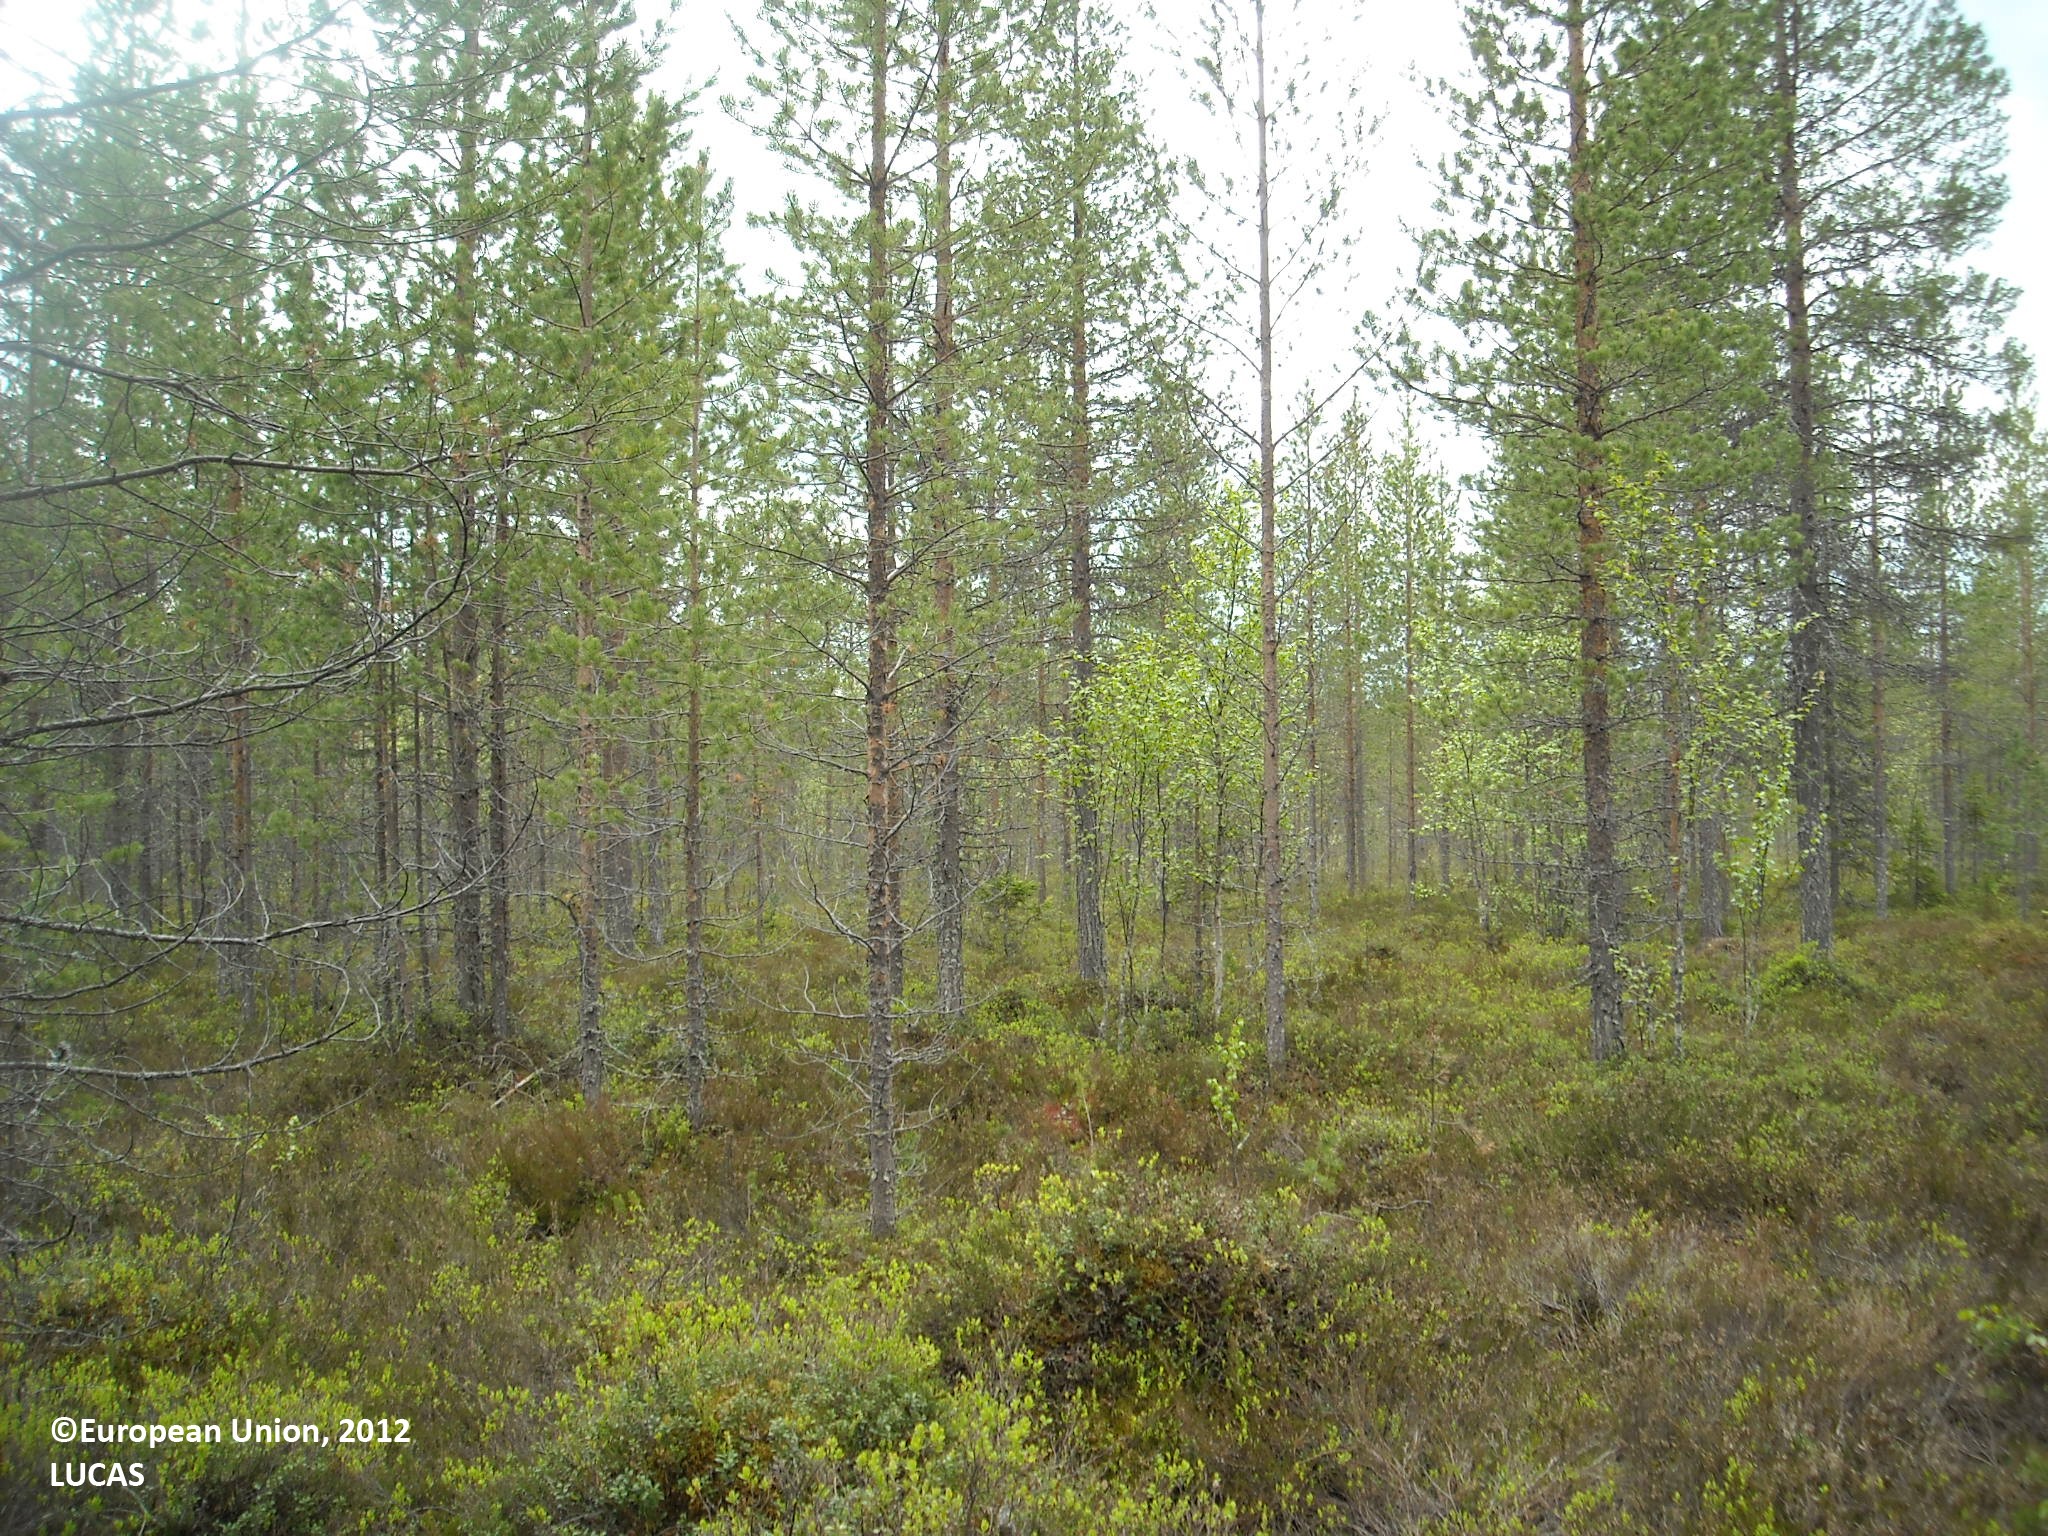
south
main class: Woodland
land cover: Pine dominated mixed woodland
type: boreal forest
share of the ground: > 75 %
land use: Forestry
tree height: > 5 m
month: June
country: FI
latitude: 65.2599
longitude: 27.8095
